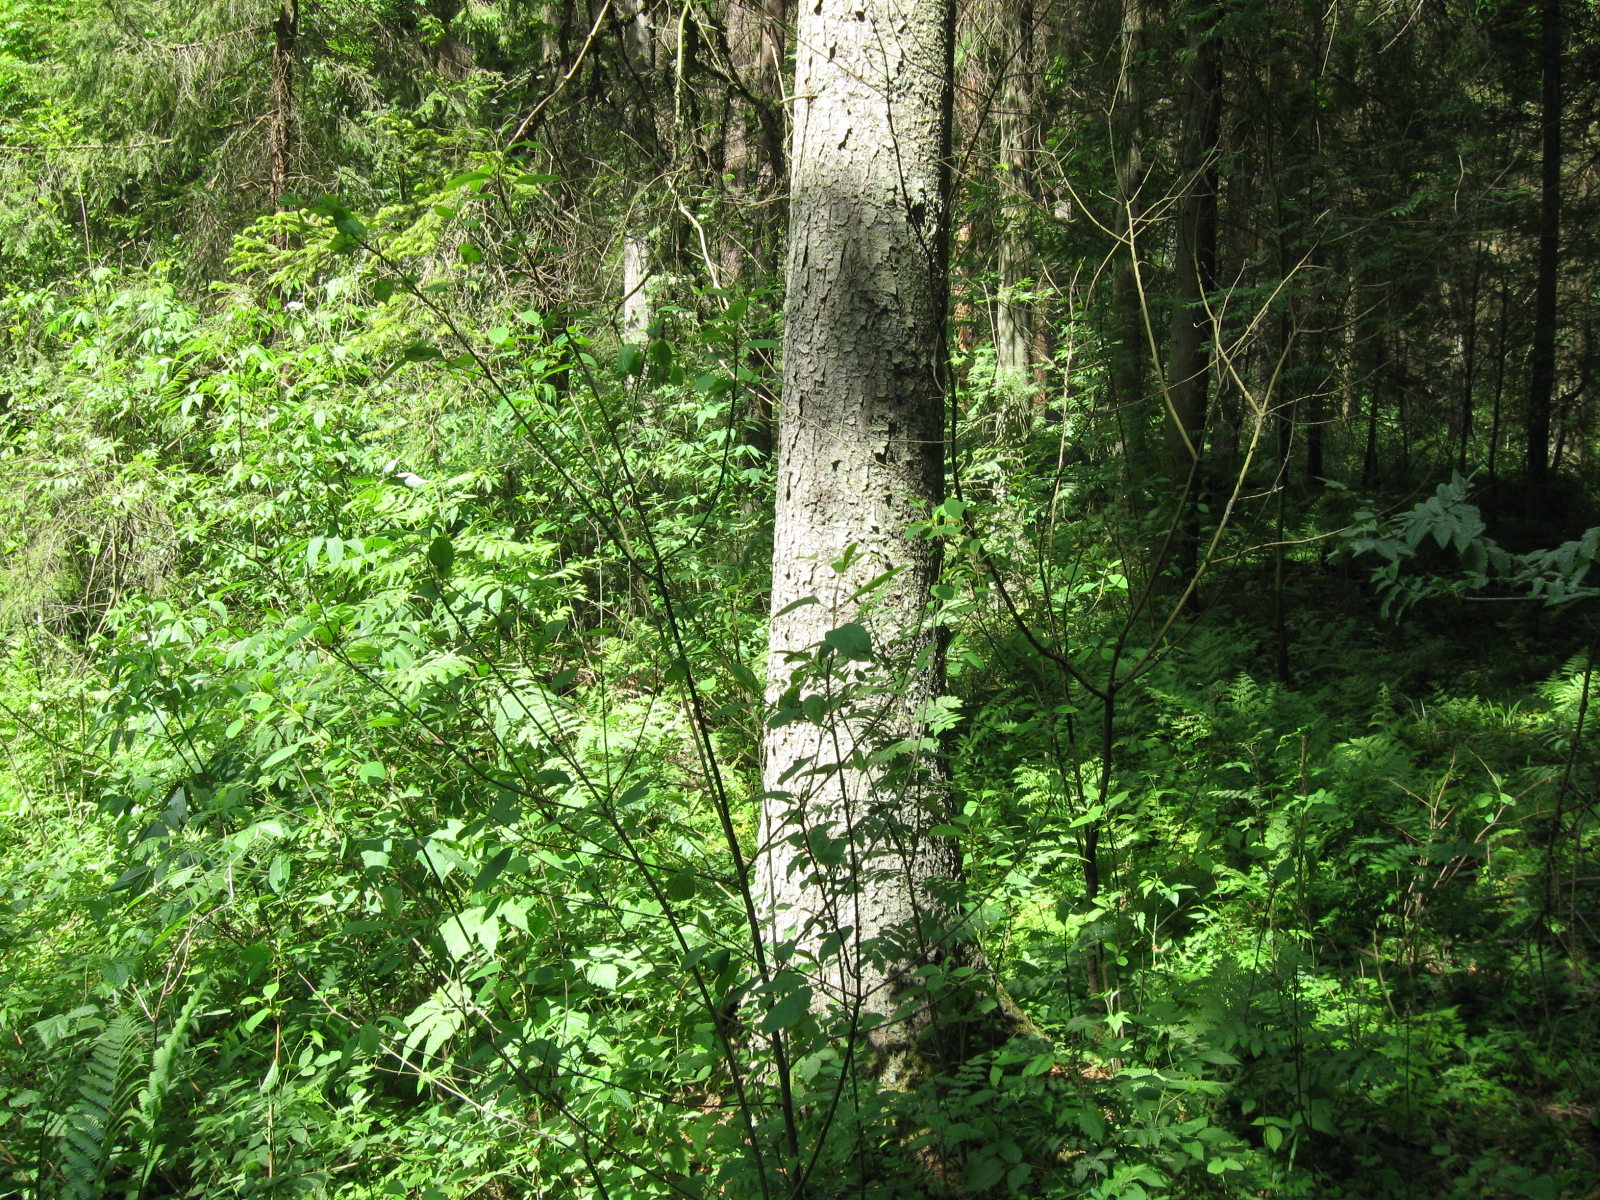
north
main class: Woodland
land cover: Spruce dominated mixed woodland
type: hemiboreal forest and nemoral coniferous forest and mixed broadleaved-coniferous forest
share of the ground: > 75 %
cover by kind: coniferous forest trees 65 %, broadleaved forest trees 30 %, herbaceous plants 5 %
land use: Forestry
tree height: > 5 m
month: June
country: LT
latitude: 54.6268
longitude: 23.8589
